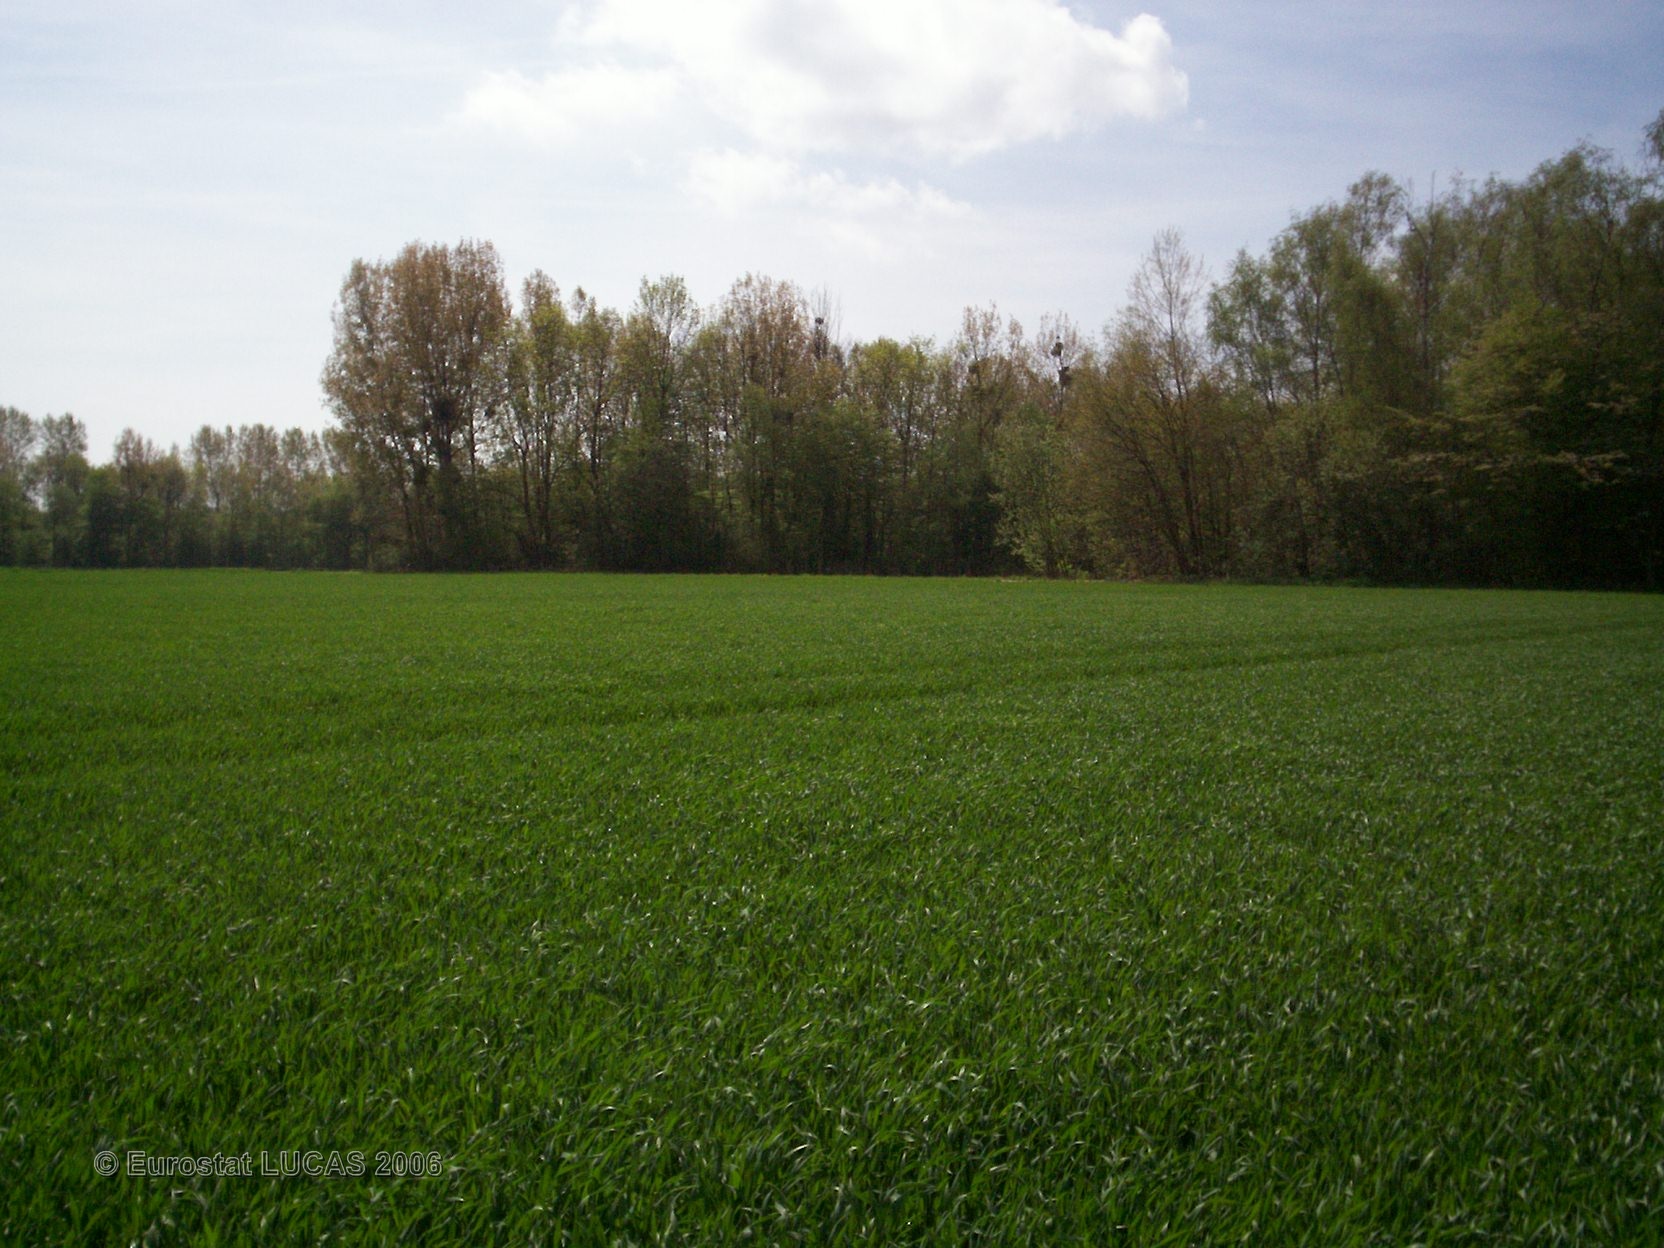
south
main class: Cropland
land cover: Common wheat
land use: Agriculture (excluding fallow land and kitchen gardens)
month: May
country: FR
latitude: 48.8411
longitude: 2.8645
